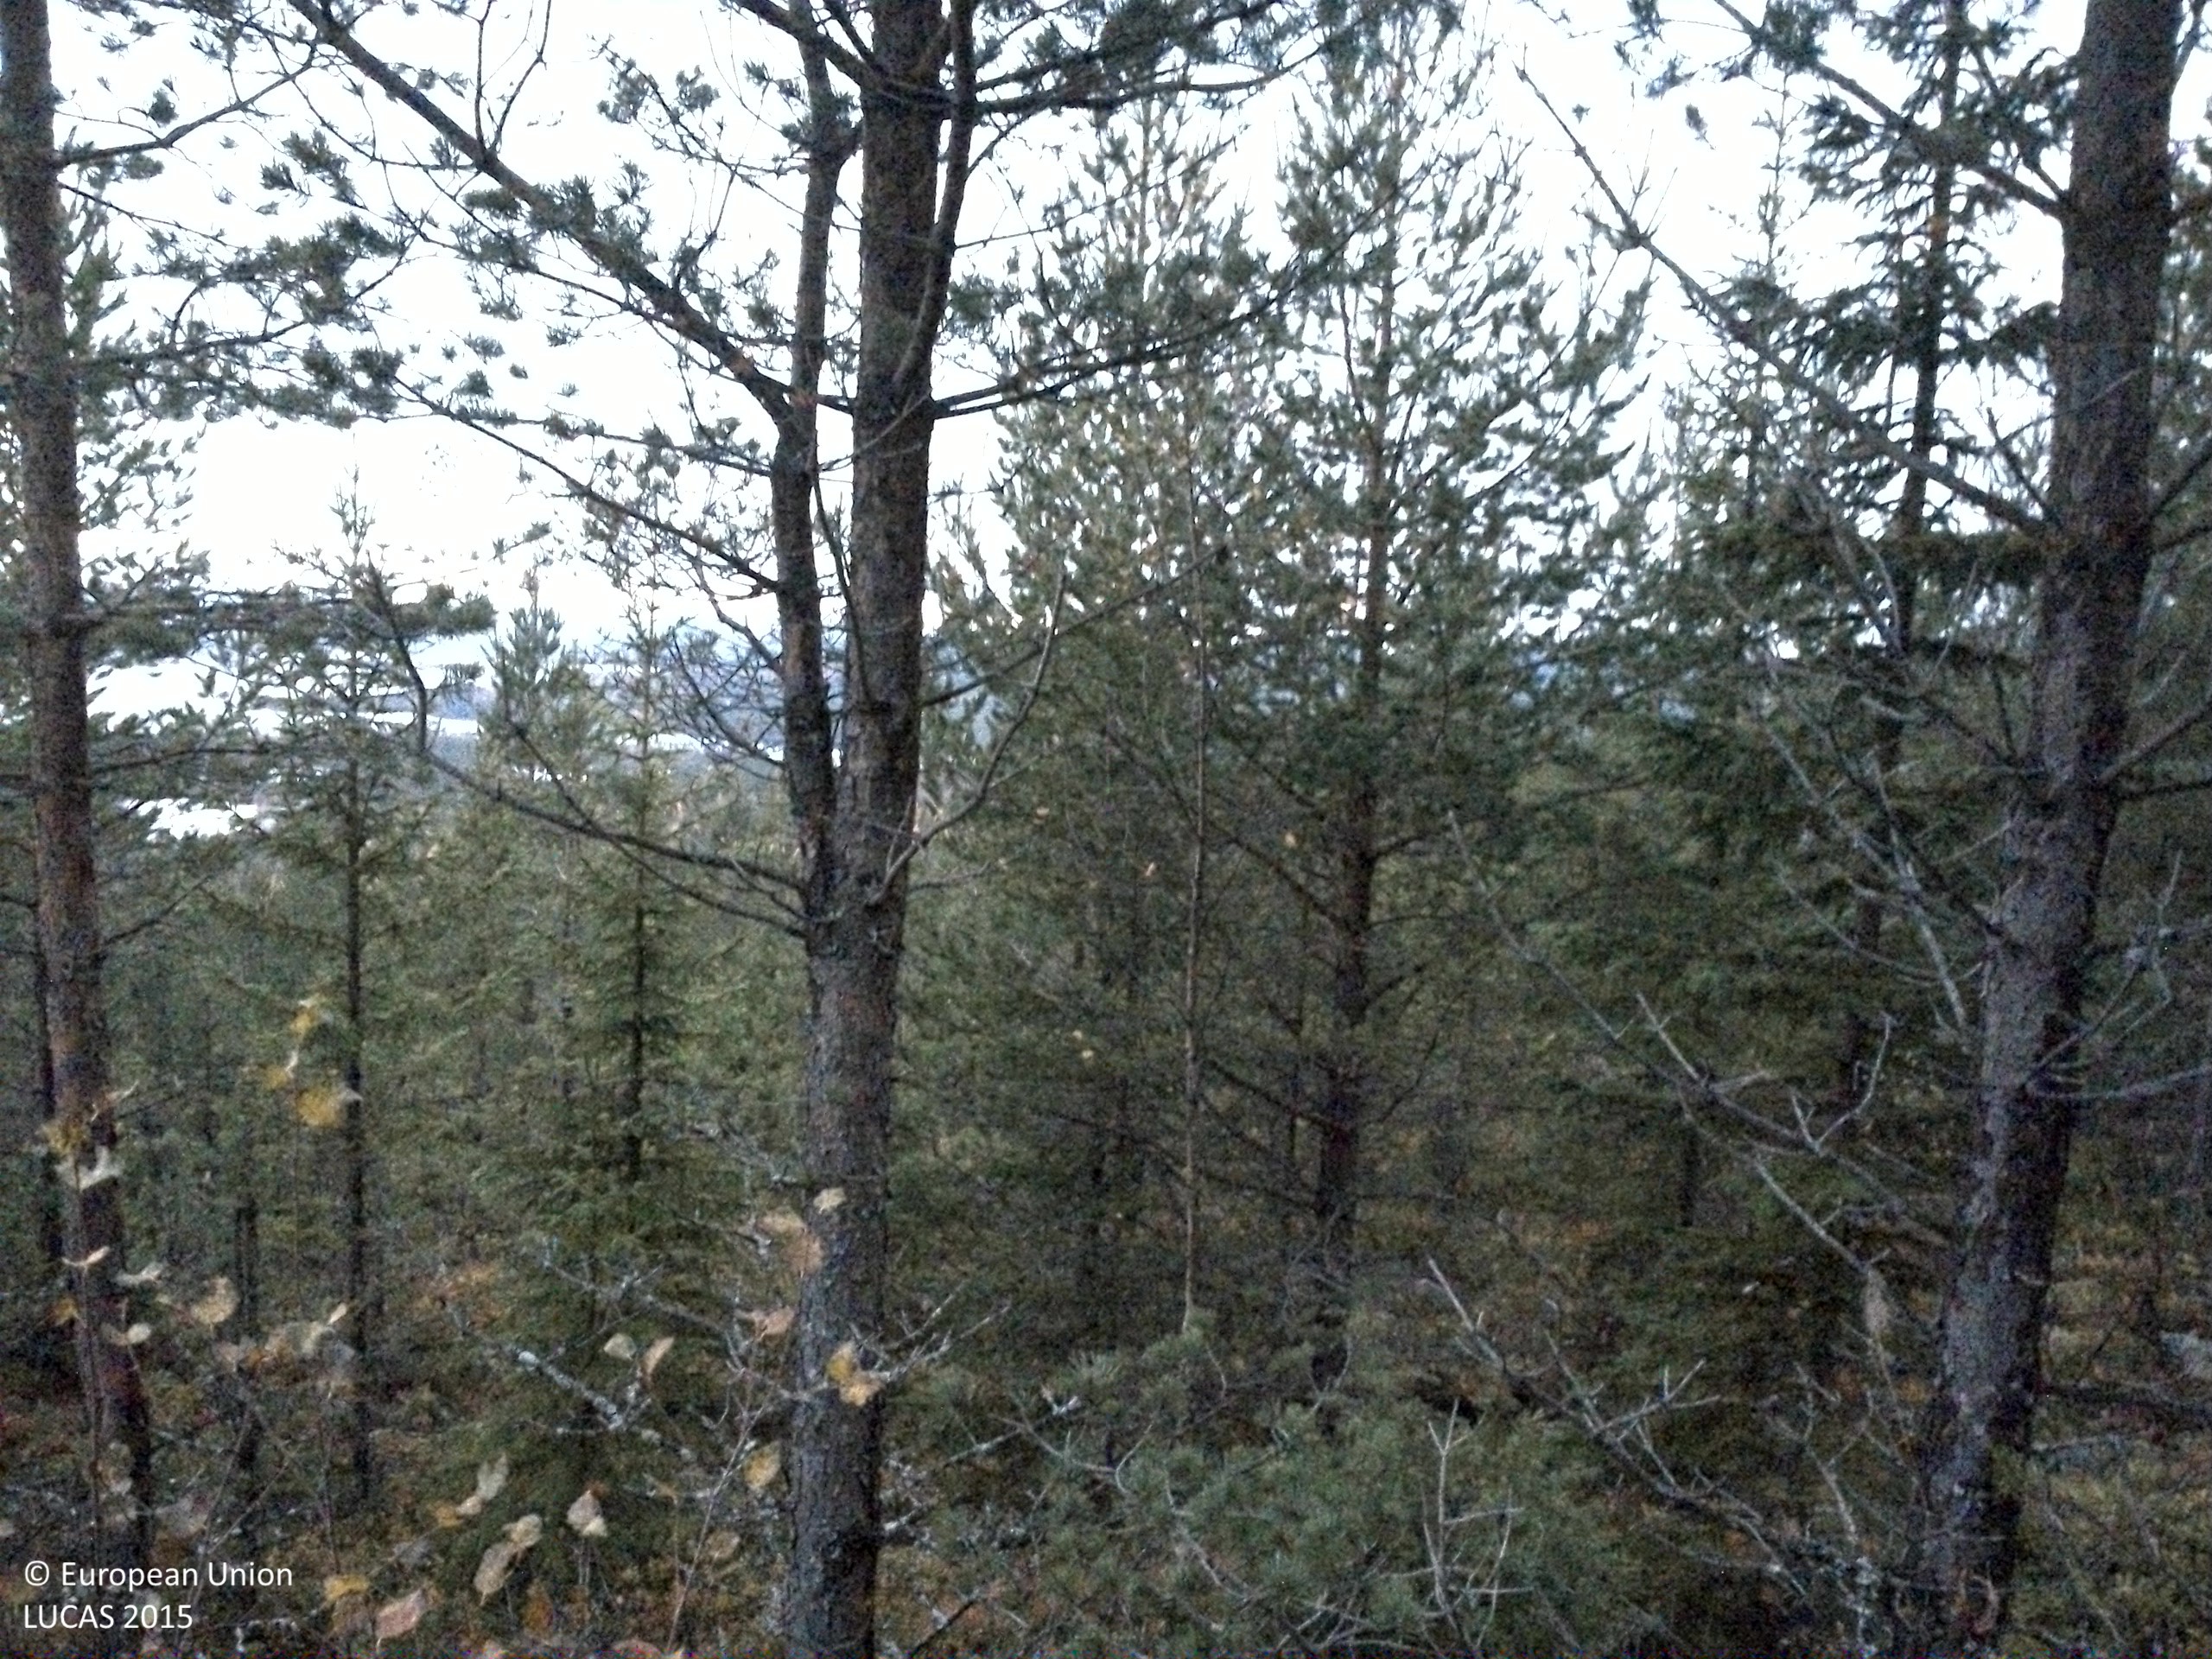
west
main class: Woodland
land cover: Pine dominated coniferous woodland
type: boreal forest
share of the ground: 25 - 50 %
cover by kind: coniferous forest trees 35 %, shrubs 25 %, consolidated bare surface 20 %, lichens and mosses 15 %, broadleaved forest trees 5 %
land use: Forestry
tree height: > 5 m
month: October
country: SE
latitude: 64.3308
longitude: 15.2066
